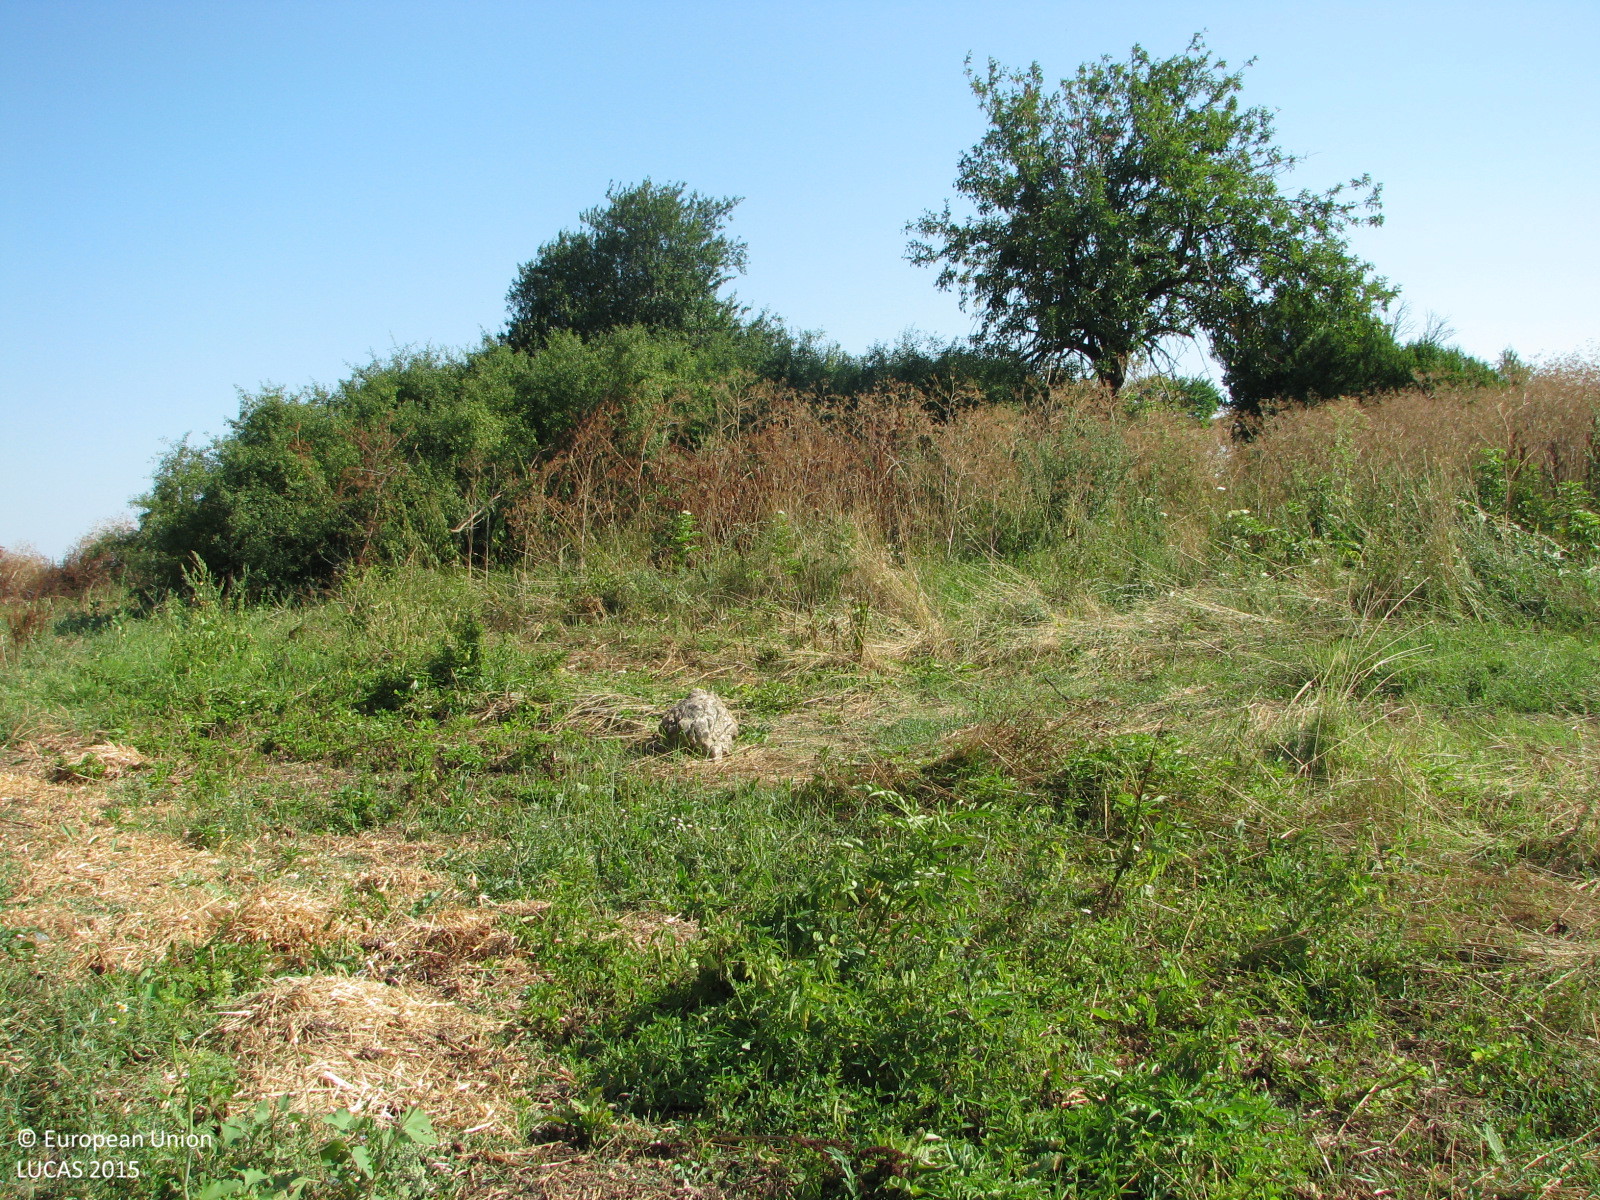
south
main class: Grassland
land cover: Spontaneously vegetated surfaces
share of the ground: > 75 %
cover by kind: herbaceous plants 100 %
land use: Agriculture (excluding fallow land and kitchen gardens)
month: July
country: BG
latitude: 42.2686
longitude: 26.9152
